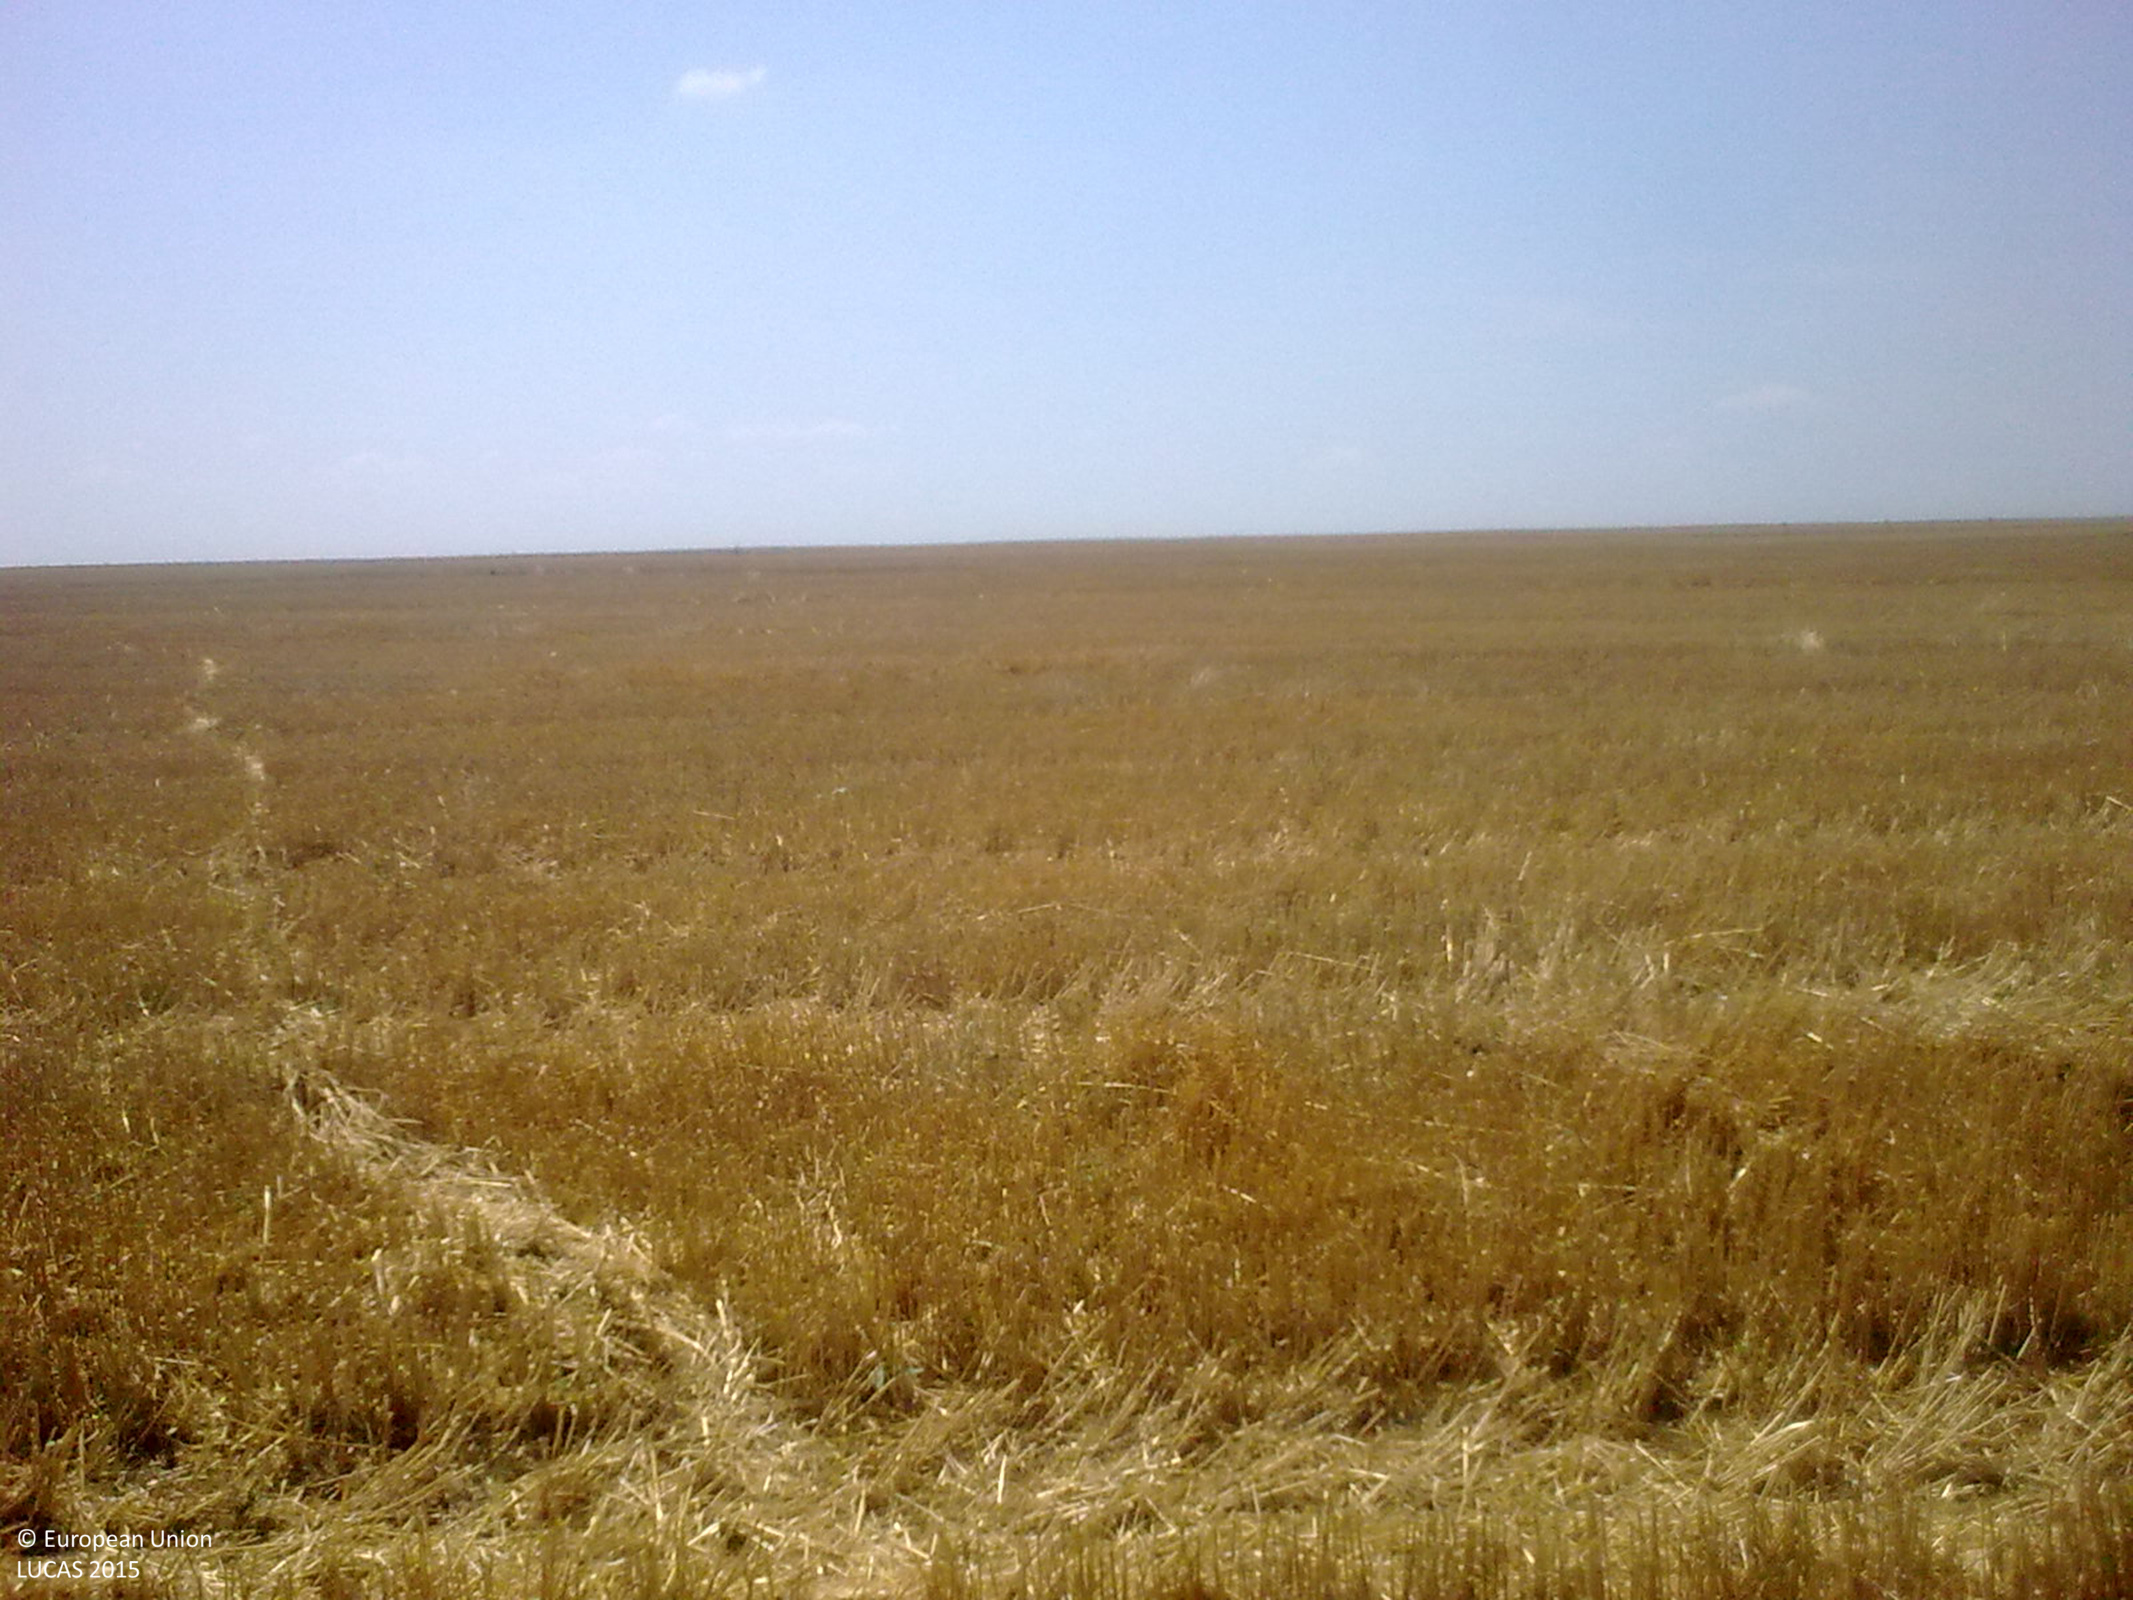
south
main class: Cropland
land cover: Common wheat
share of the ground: > 75 %
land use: Agriculture (excluding fallow land and kitchen gardens)
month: July
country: BG
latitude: 43.7948
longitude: 26.2459
